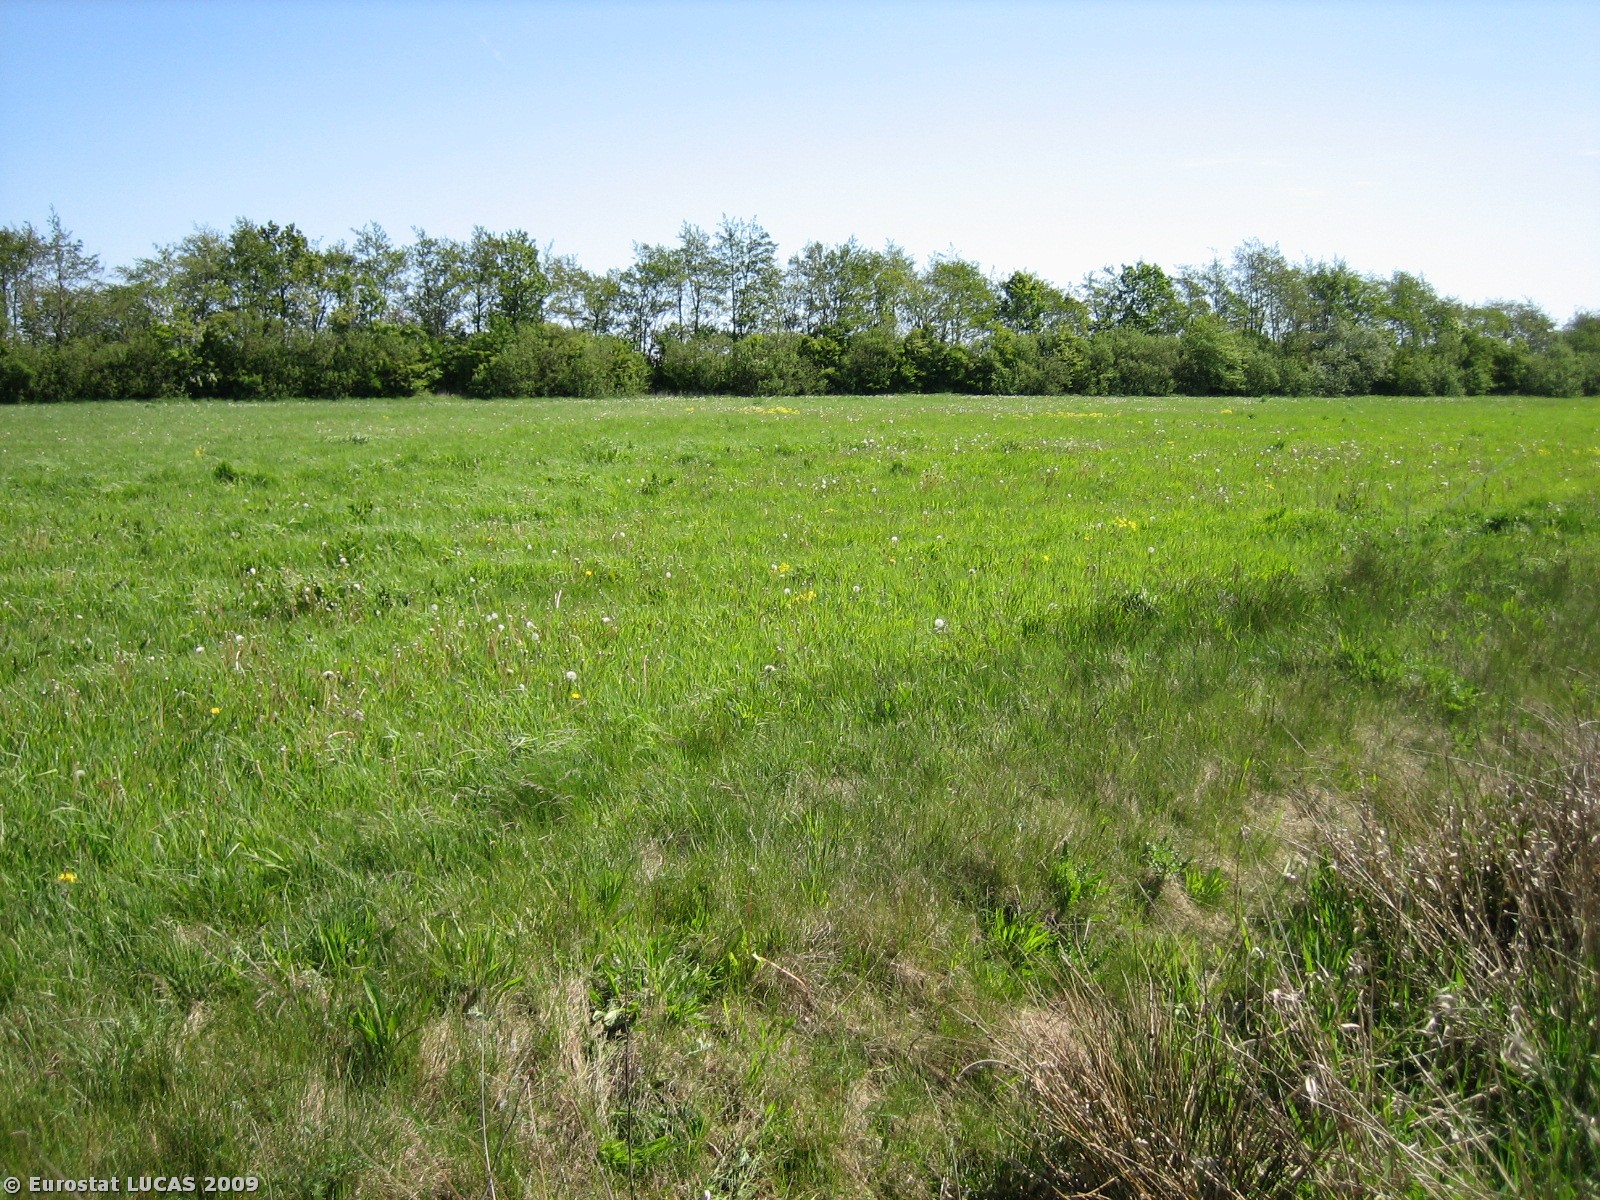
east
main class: Grassland
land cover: Grassland without tree/shrub cover
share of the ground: > 75 %
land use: Unused
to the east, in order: Grassland without tree/shrub cover; Ditches and canals; Grassland without tree/shrub cover; Broadleaved woodland; Grass margins; Tracks; Grassland without tree/shrub cover; Broadleaved woodland; Inland marshes; Grassland without tree/shrub cover; Single bushes/trees; Grassland without tree/shrub cover; Broadleaved woodland
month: May
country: DK
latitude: 55.9630
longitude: 8.4797
